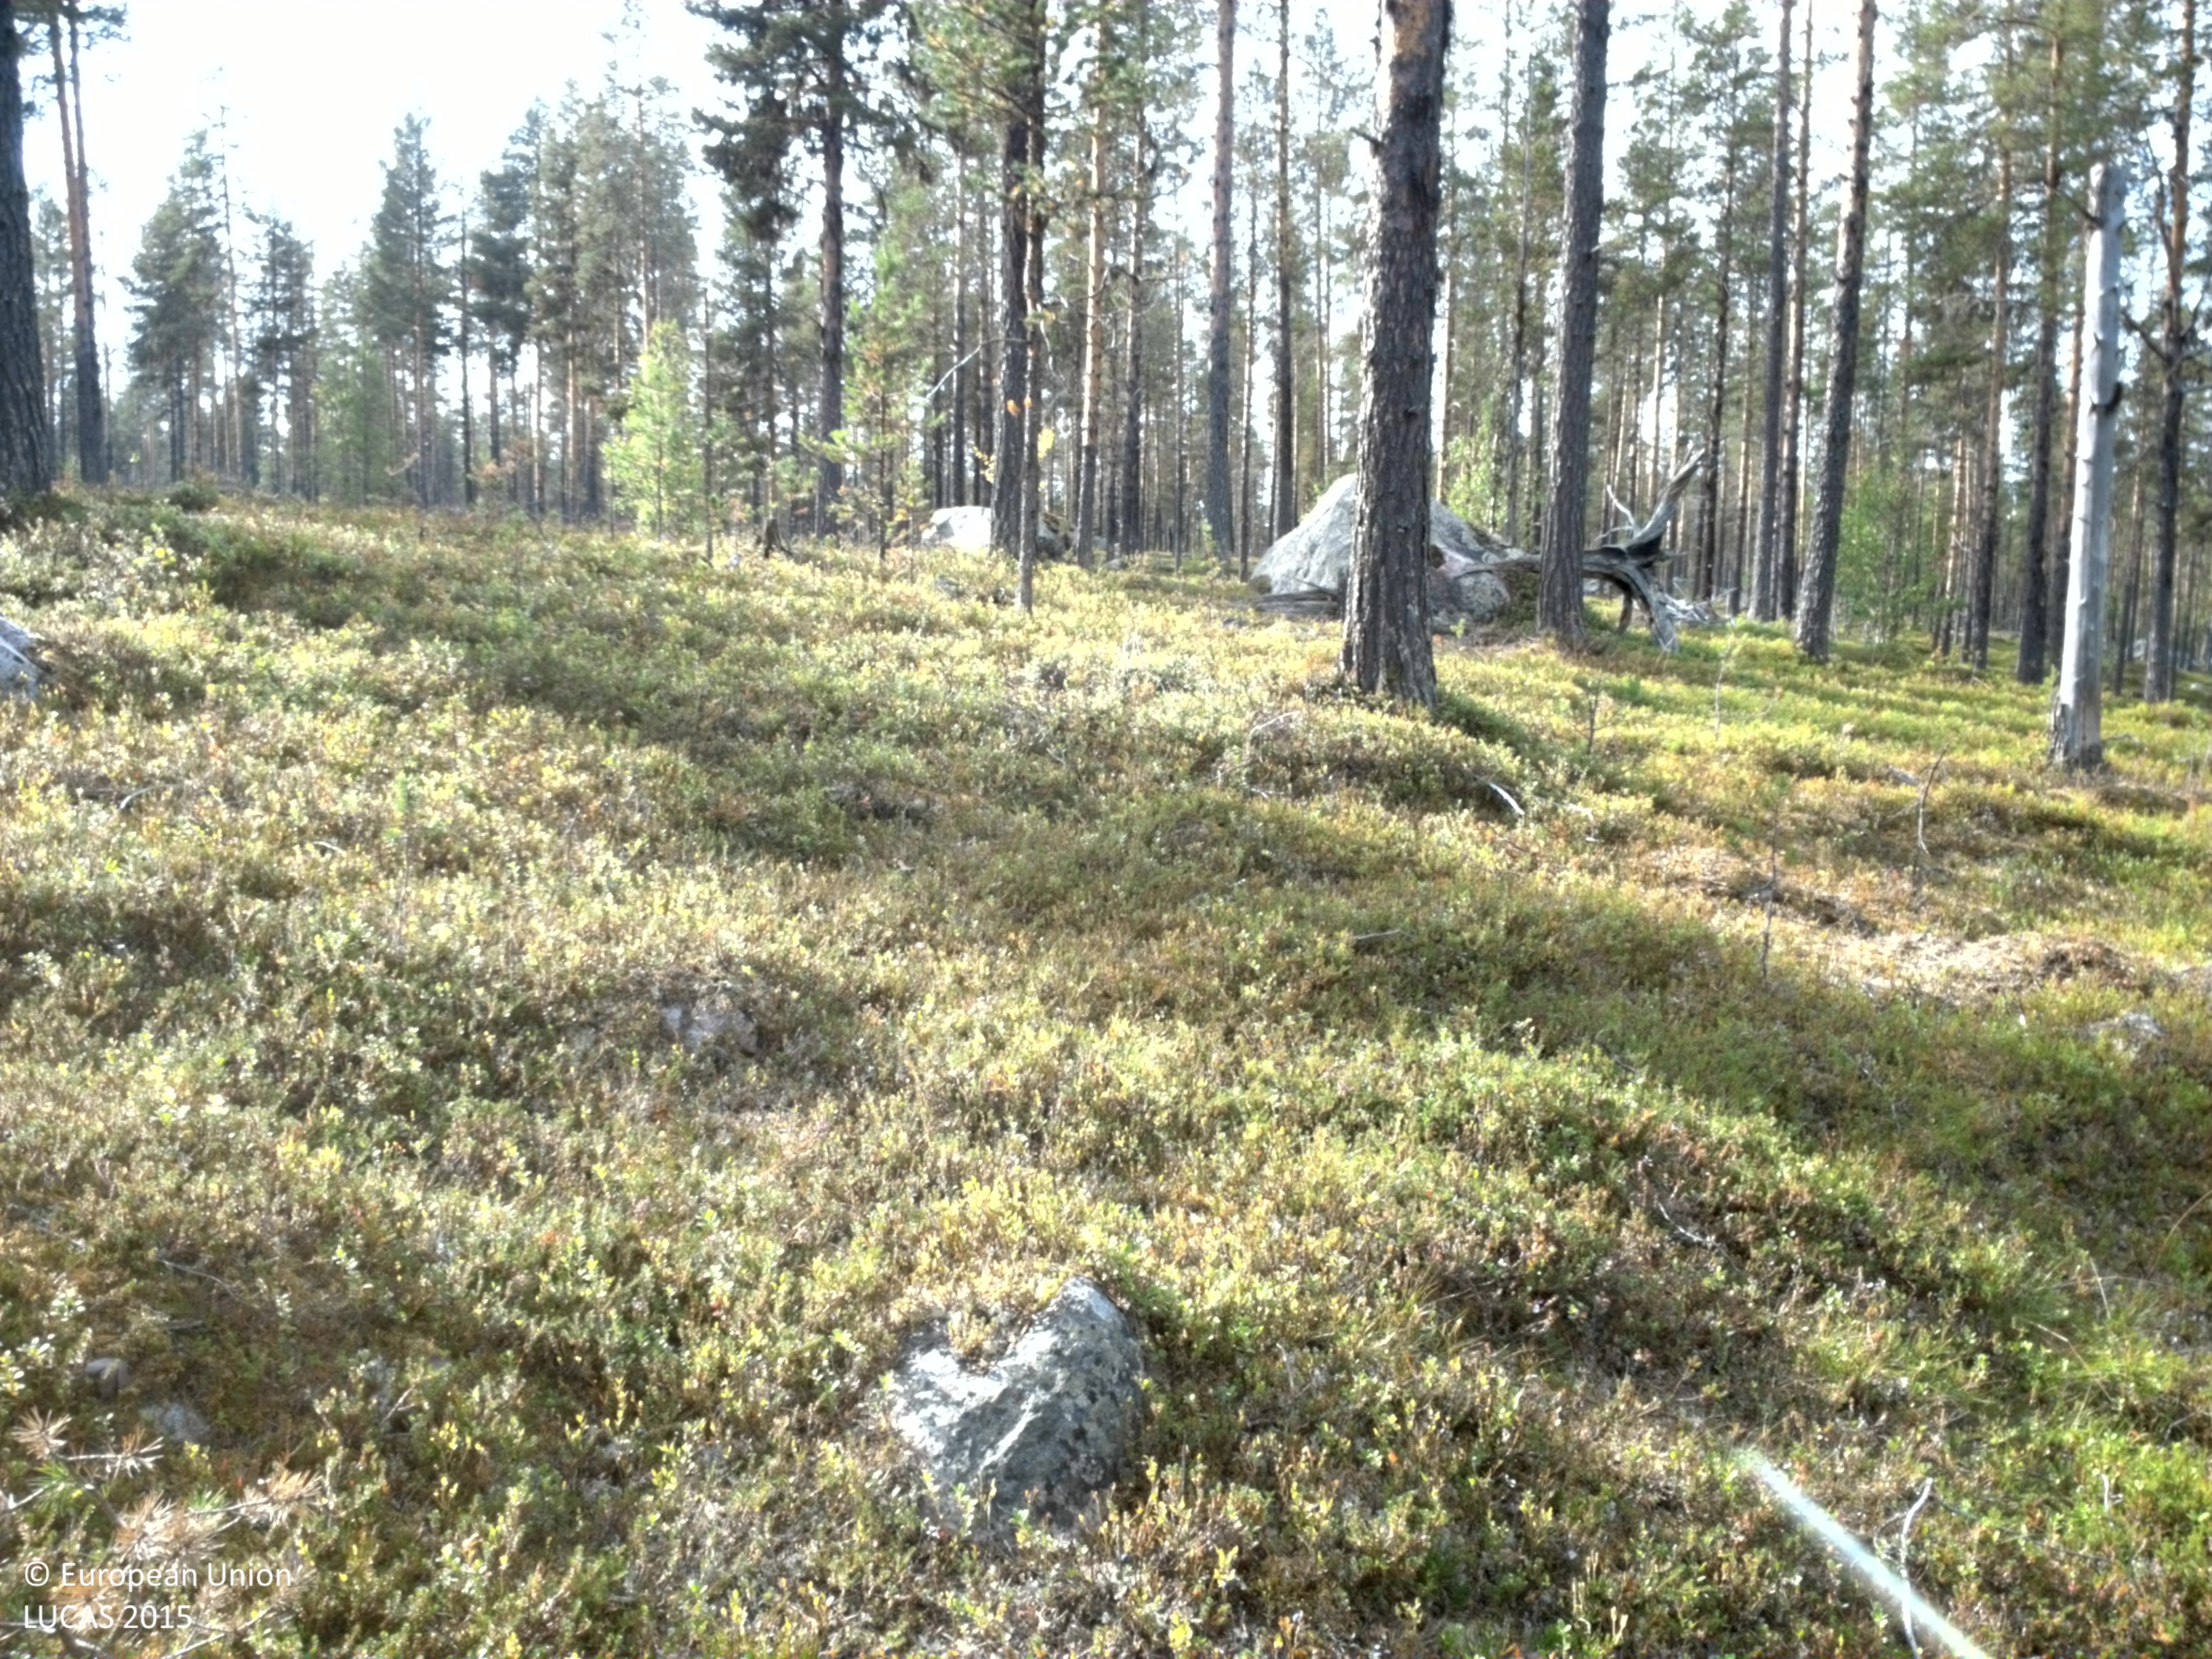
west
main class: Woodland
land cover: Pine dominated coniferous woodland
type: boreal forest
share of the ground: 25 - 50 %
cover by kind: shrubs 60 %, coniferous forest trees 25 %, broadleaved forest trees 5 %, lichens and mosses 5 %, consolidated bare surface 5 %
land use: Forestry
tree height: > 5 m
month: August
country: SE
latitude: 66.8920
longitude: 19.6986
